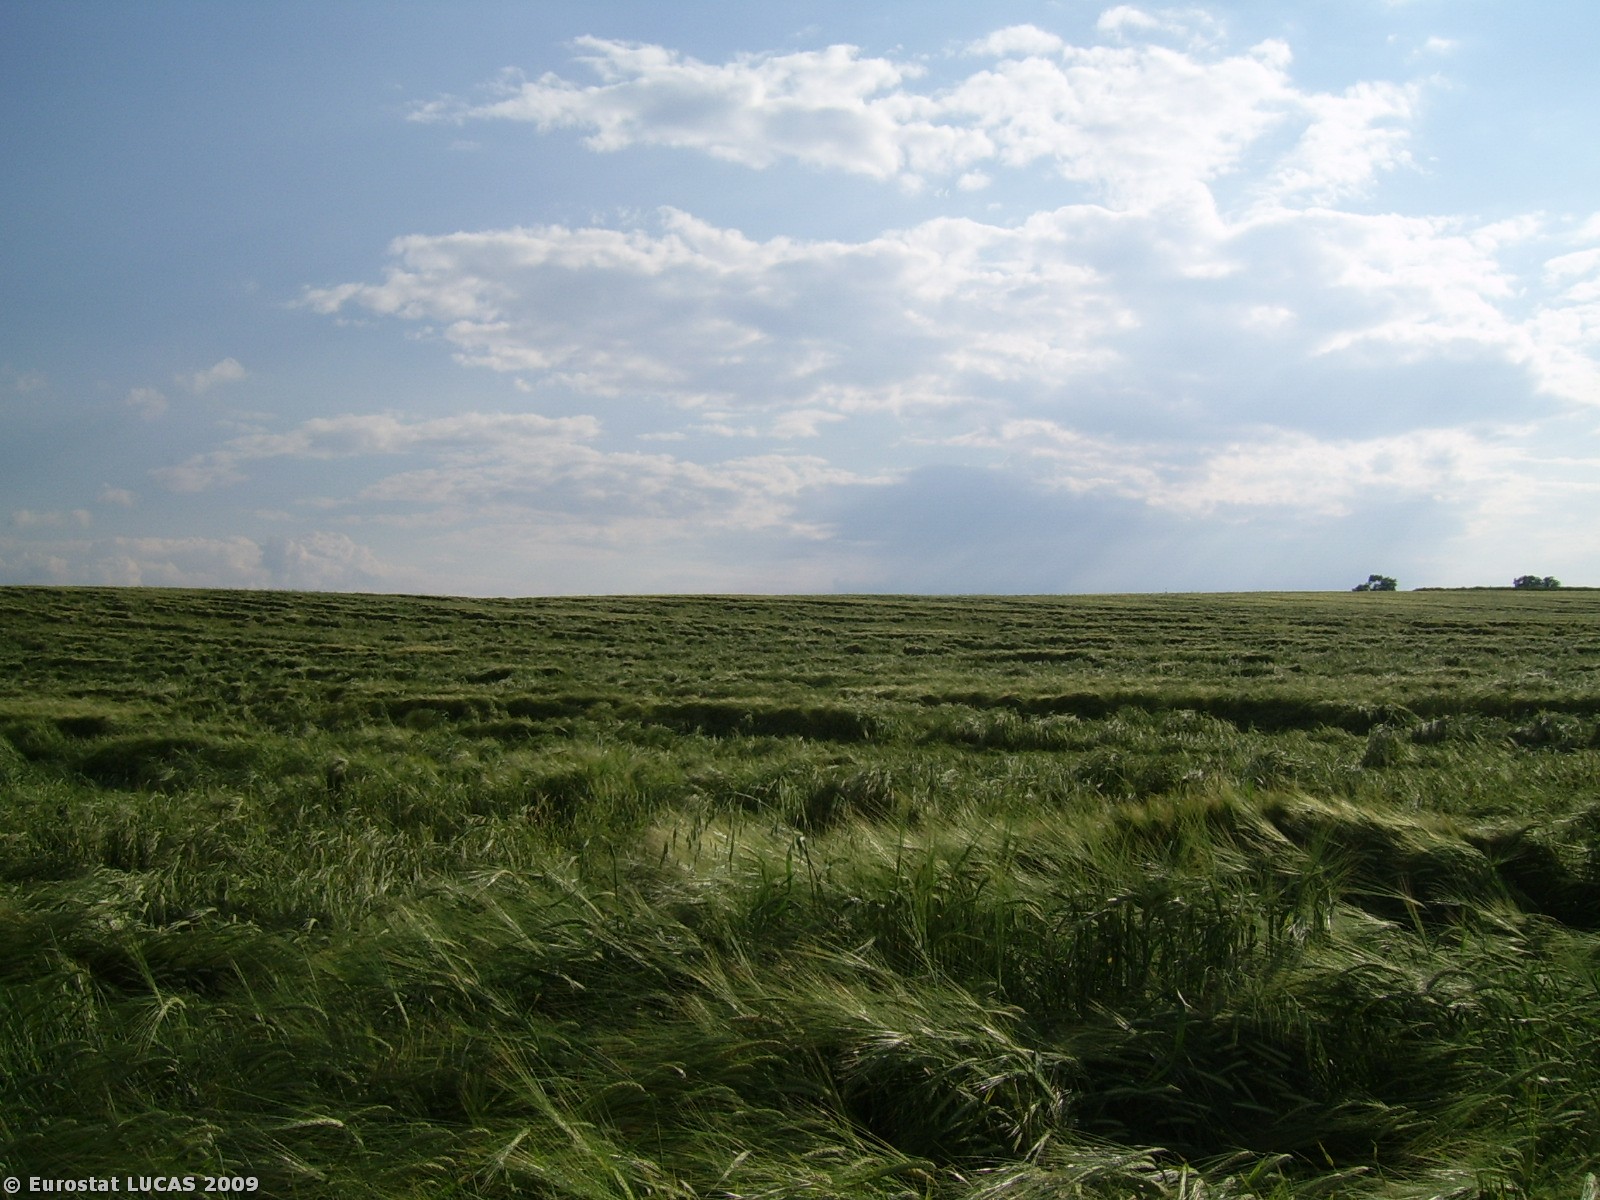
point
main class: Cropland
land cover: Barley
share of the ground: > 75 %
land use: Agriculture (excluding fallow land and kitchen gardens)
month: July
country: PL
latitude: 52.9260
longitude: 18.1829
